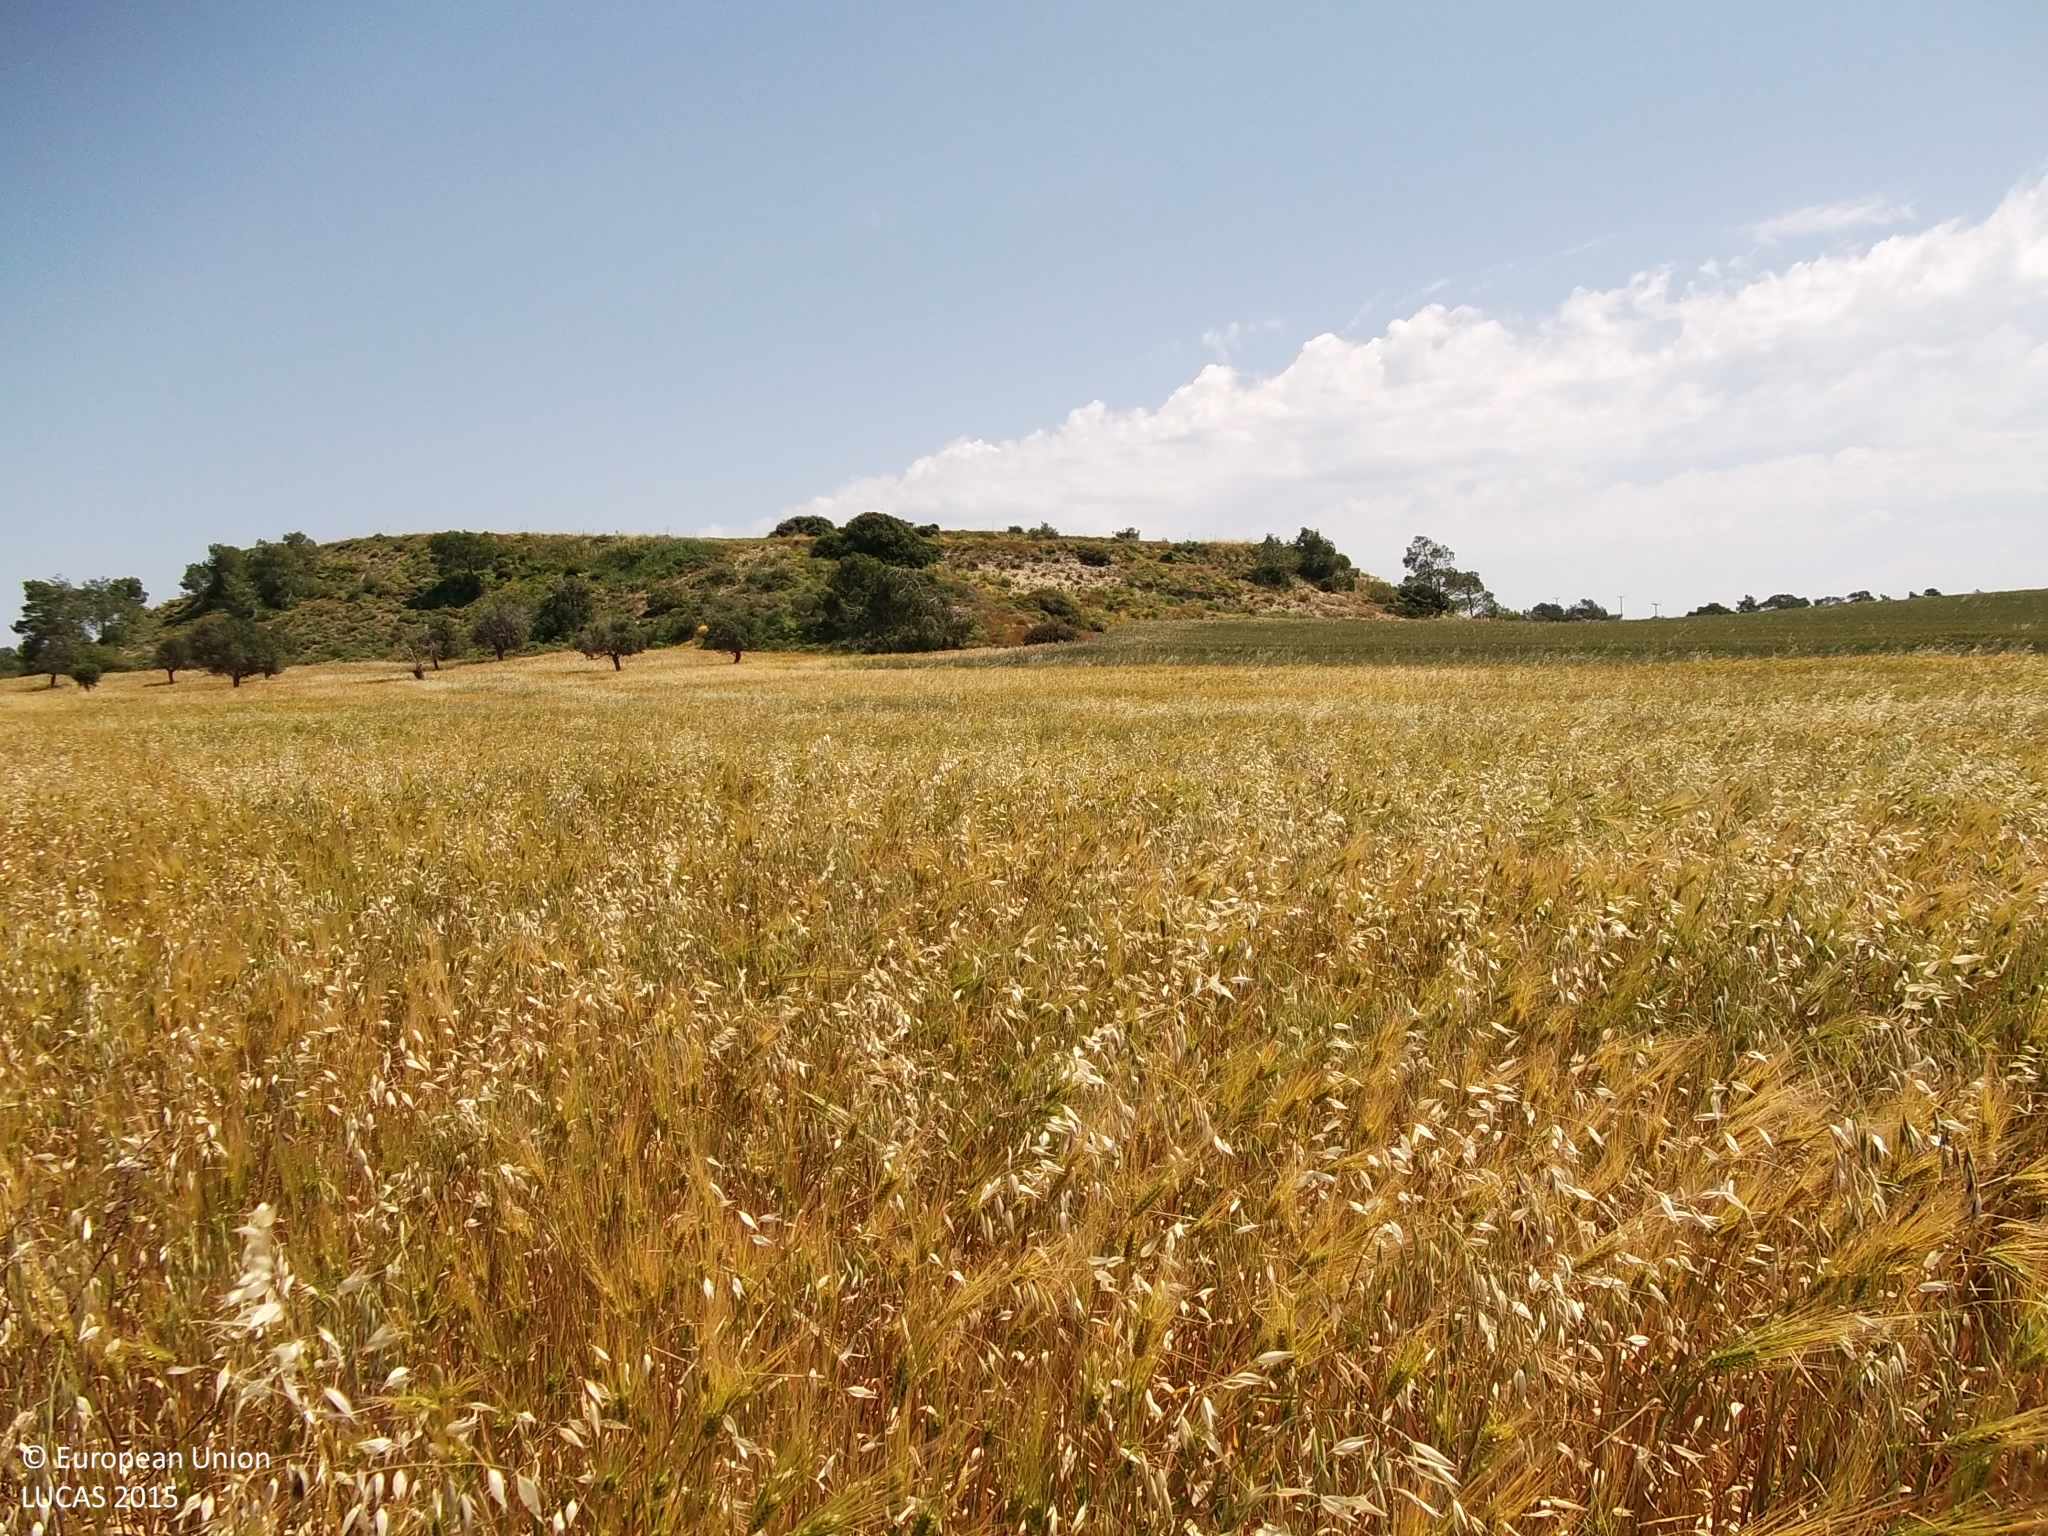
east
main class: Cropland
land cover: Mixed cereals for fodder
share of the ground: > 75 %
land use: Agriculture (excluding fallow land and kitchen gardens)
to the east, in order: Mixed cereals for fodder; Common wheat; Shrubland without tree cover; Tracks; Spontaneously vegetated surfaces; Shrubland without tree cover; Spontaneously vegetated surfaces; Shrubland without tree cover
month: April
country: CY
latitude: 34.8188
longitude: 33.4847
